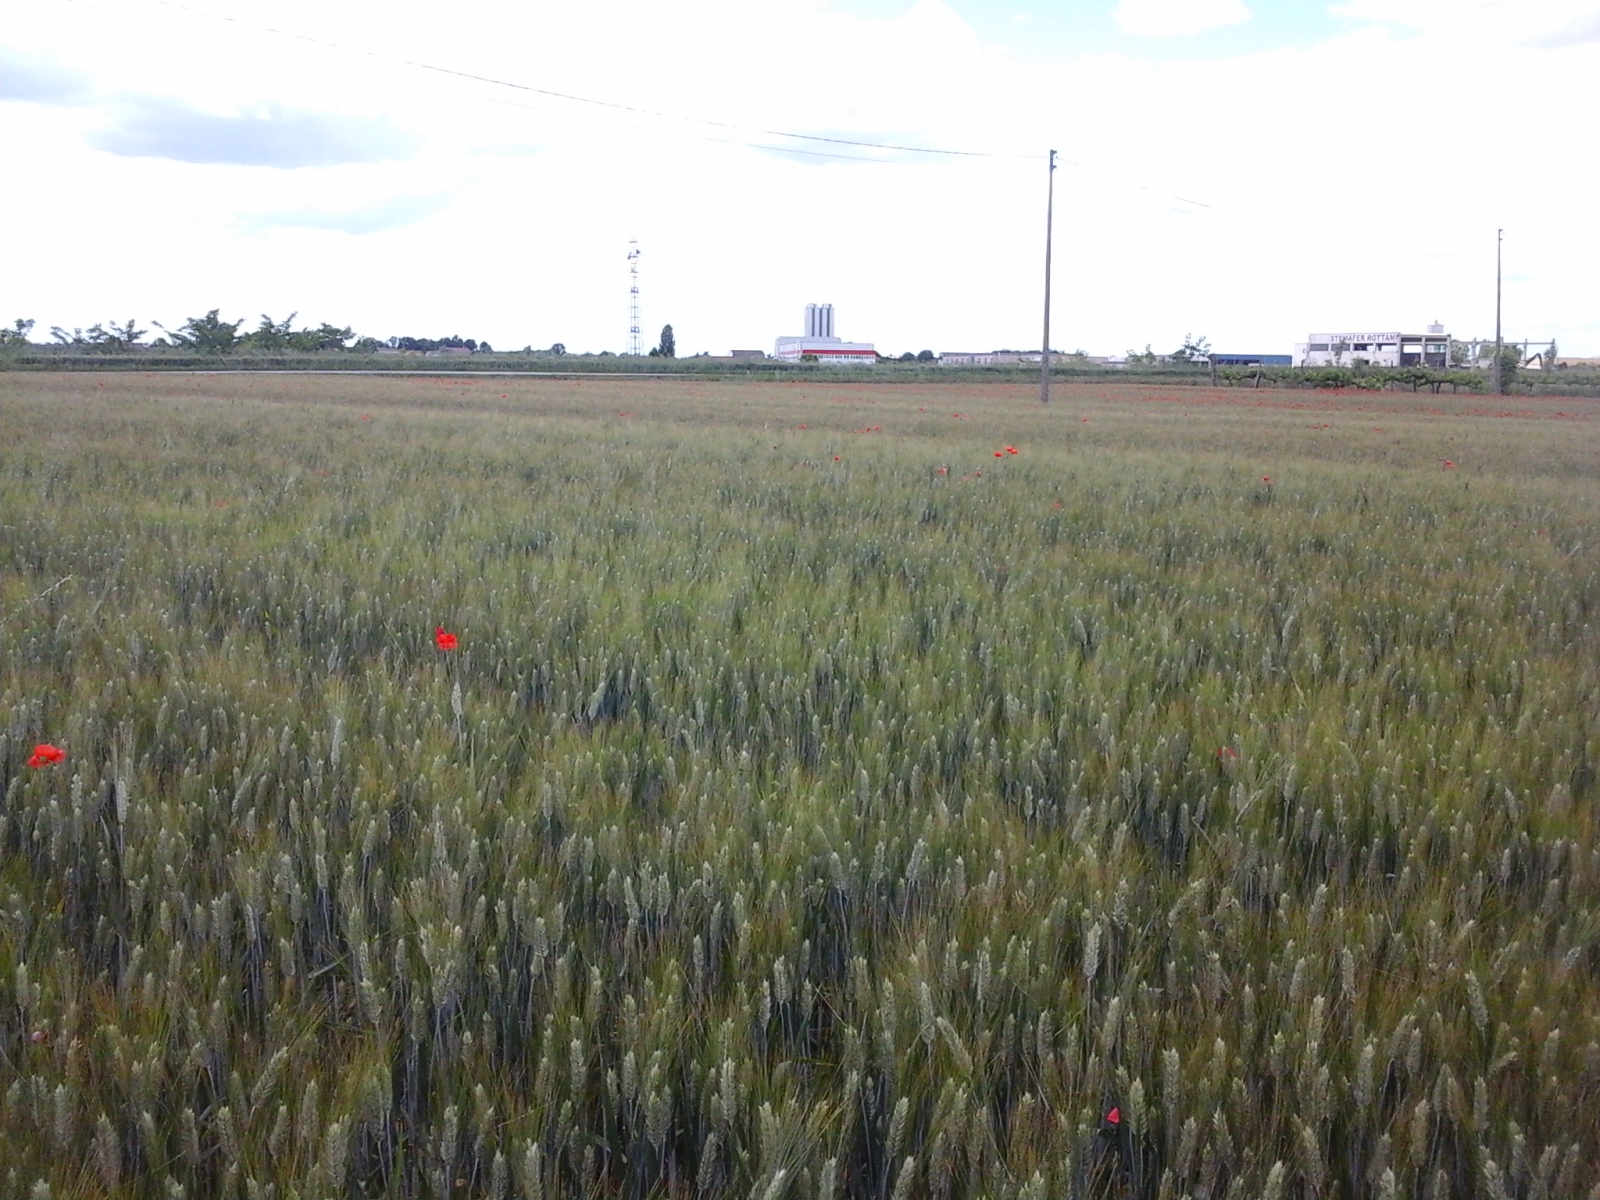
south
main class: Cropland
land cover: Durum wheat
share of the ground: > 75 %
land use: Agriculture (excluding fallow land and kitchen gardens)
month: May
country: IT
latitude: 45.0422
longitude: 11.5586
